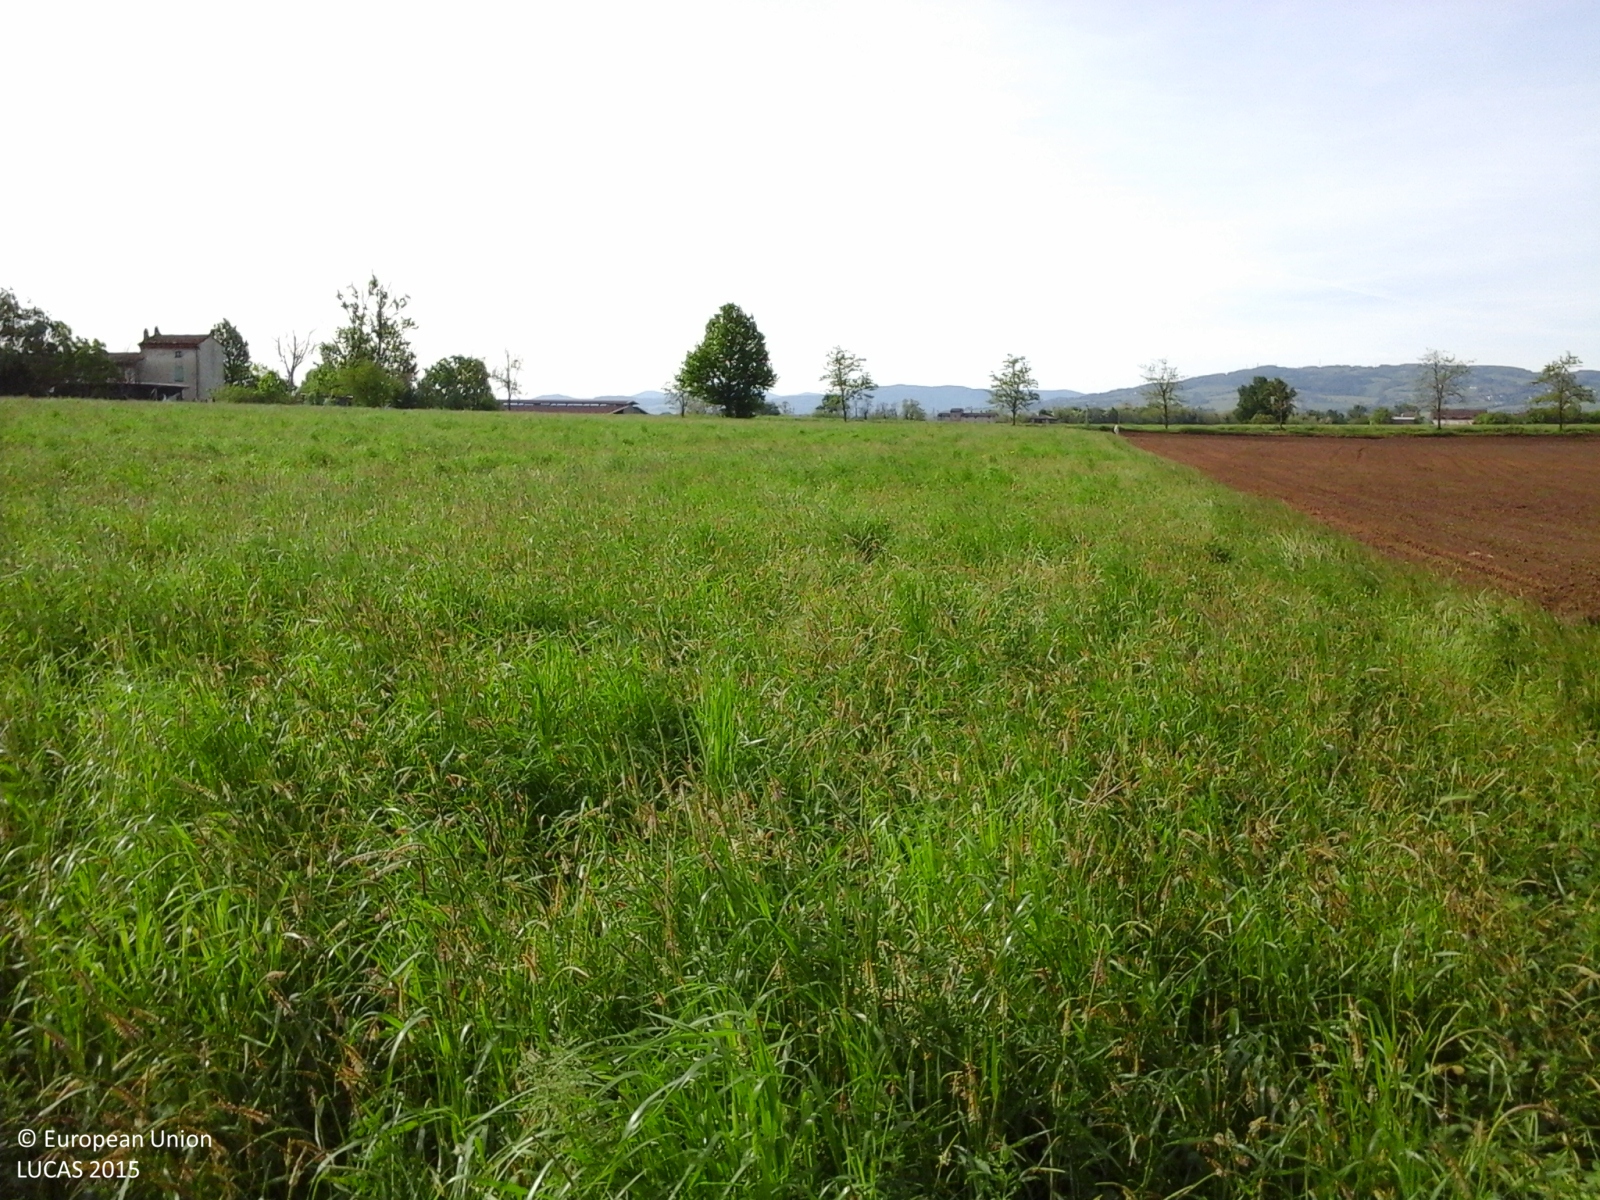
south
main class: Cropland
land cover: Lucerne
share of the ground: > 75 %
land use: Agriculture (excluding fallow land and kitchen gardens)
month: May
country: IT
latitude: 44.9807
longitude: 9.5570
